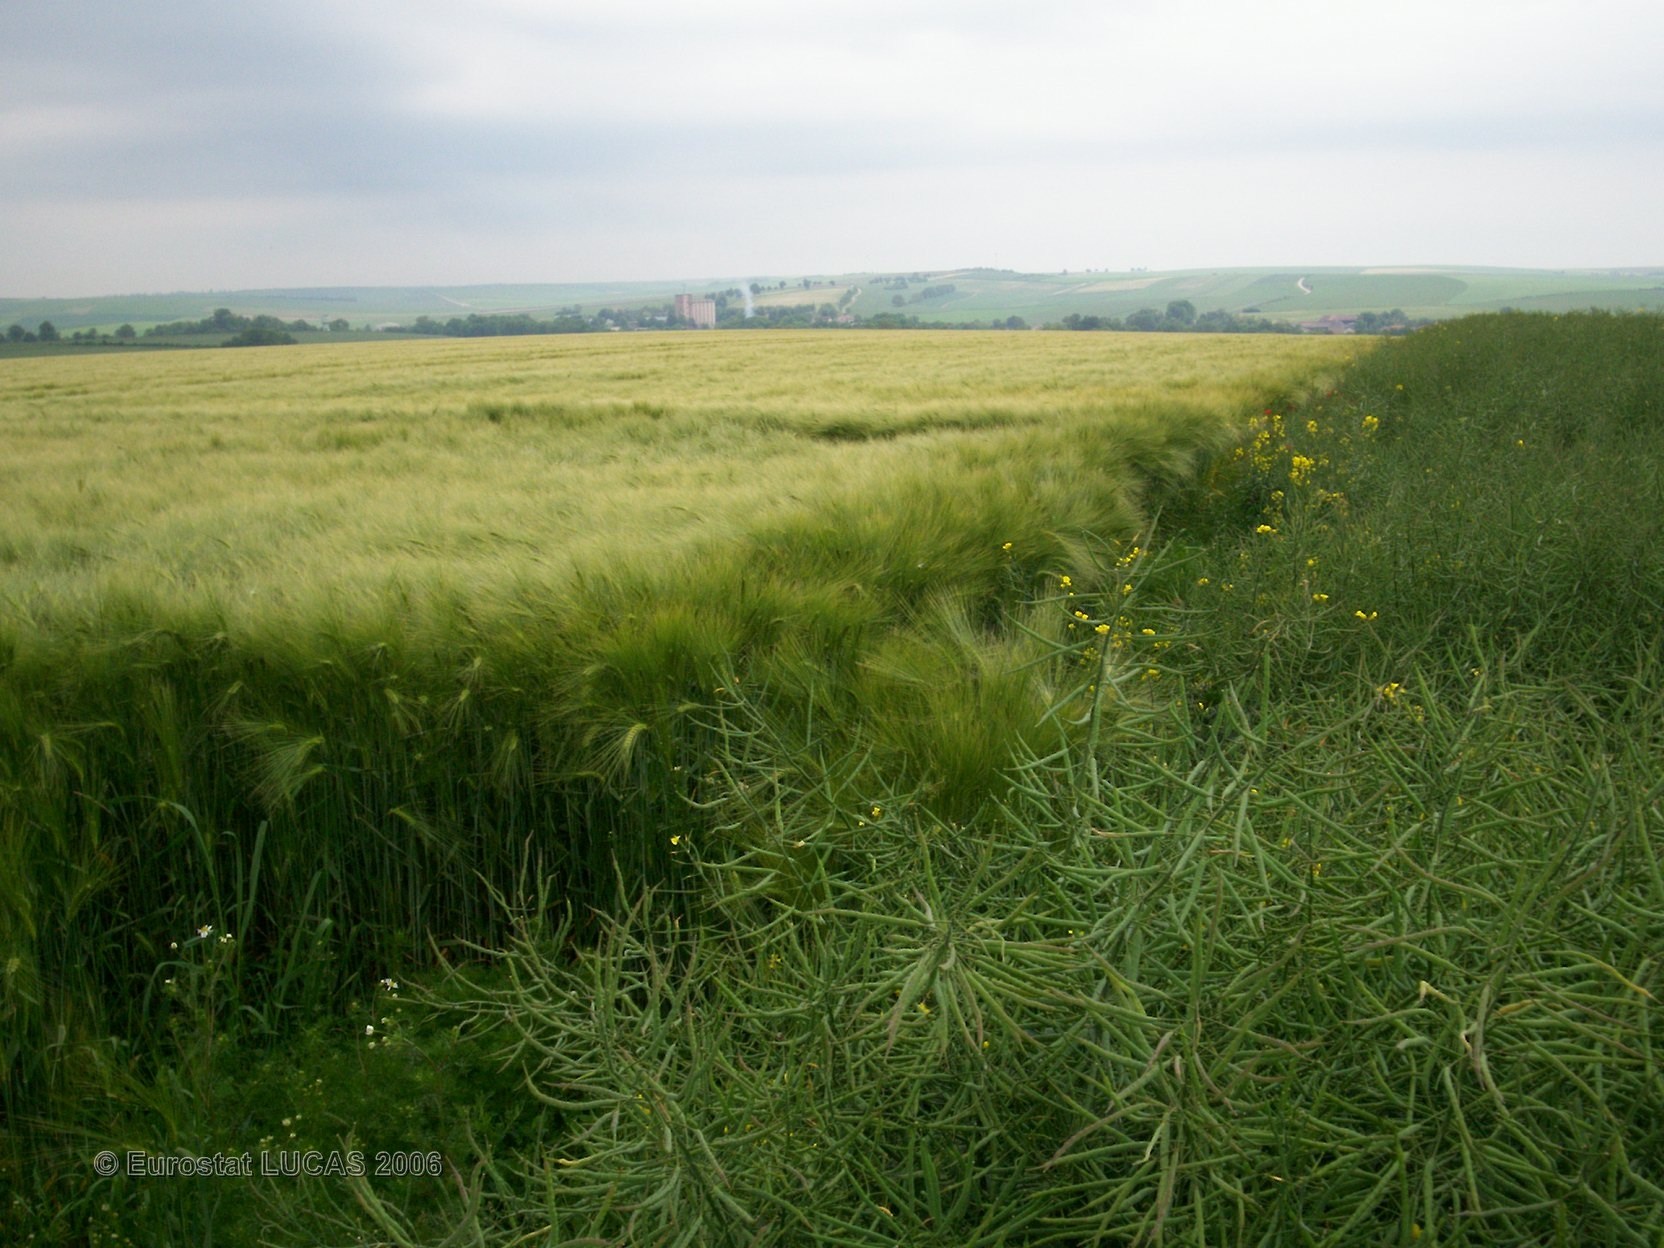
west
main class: Cropland
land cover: Rape and turnip rape
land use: Agriculture (excluding fallow land and kitchen gardens)
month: June
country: FR
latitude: 48.7489
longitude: 4.4069
